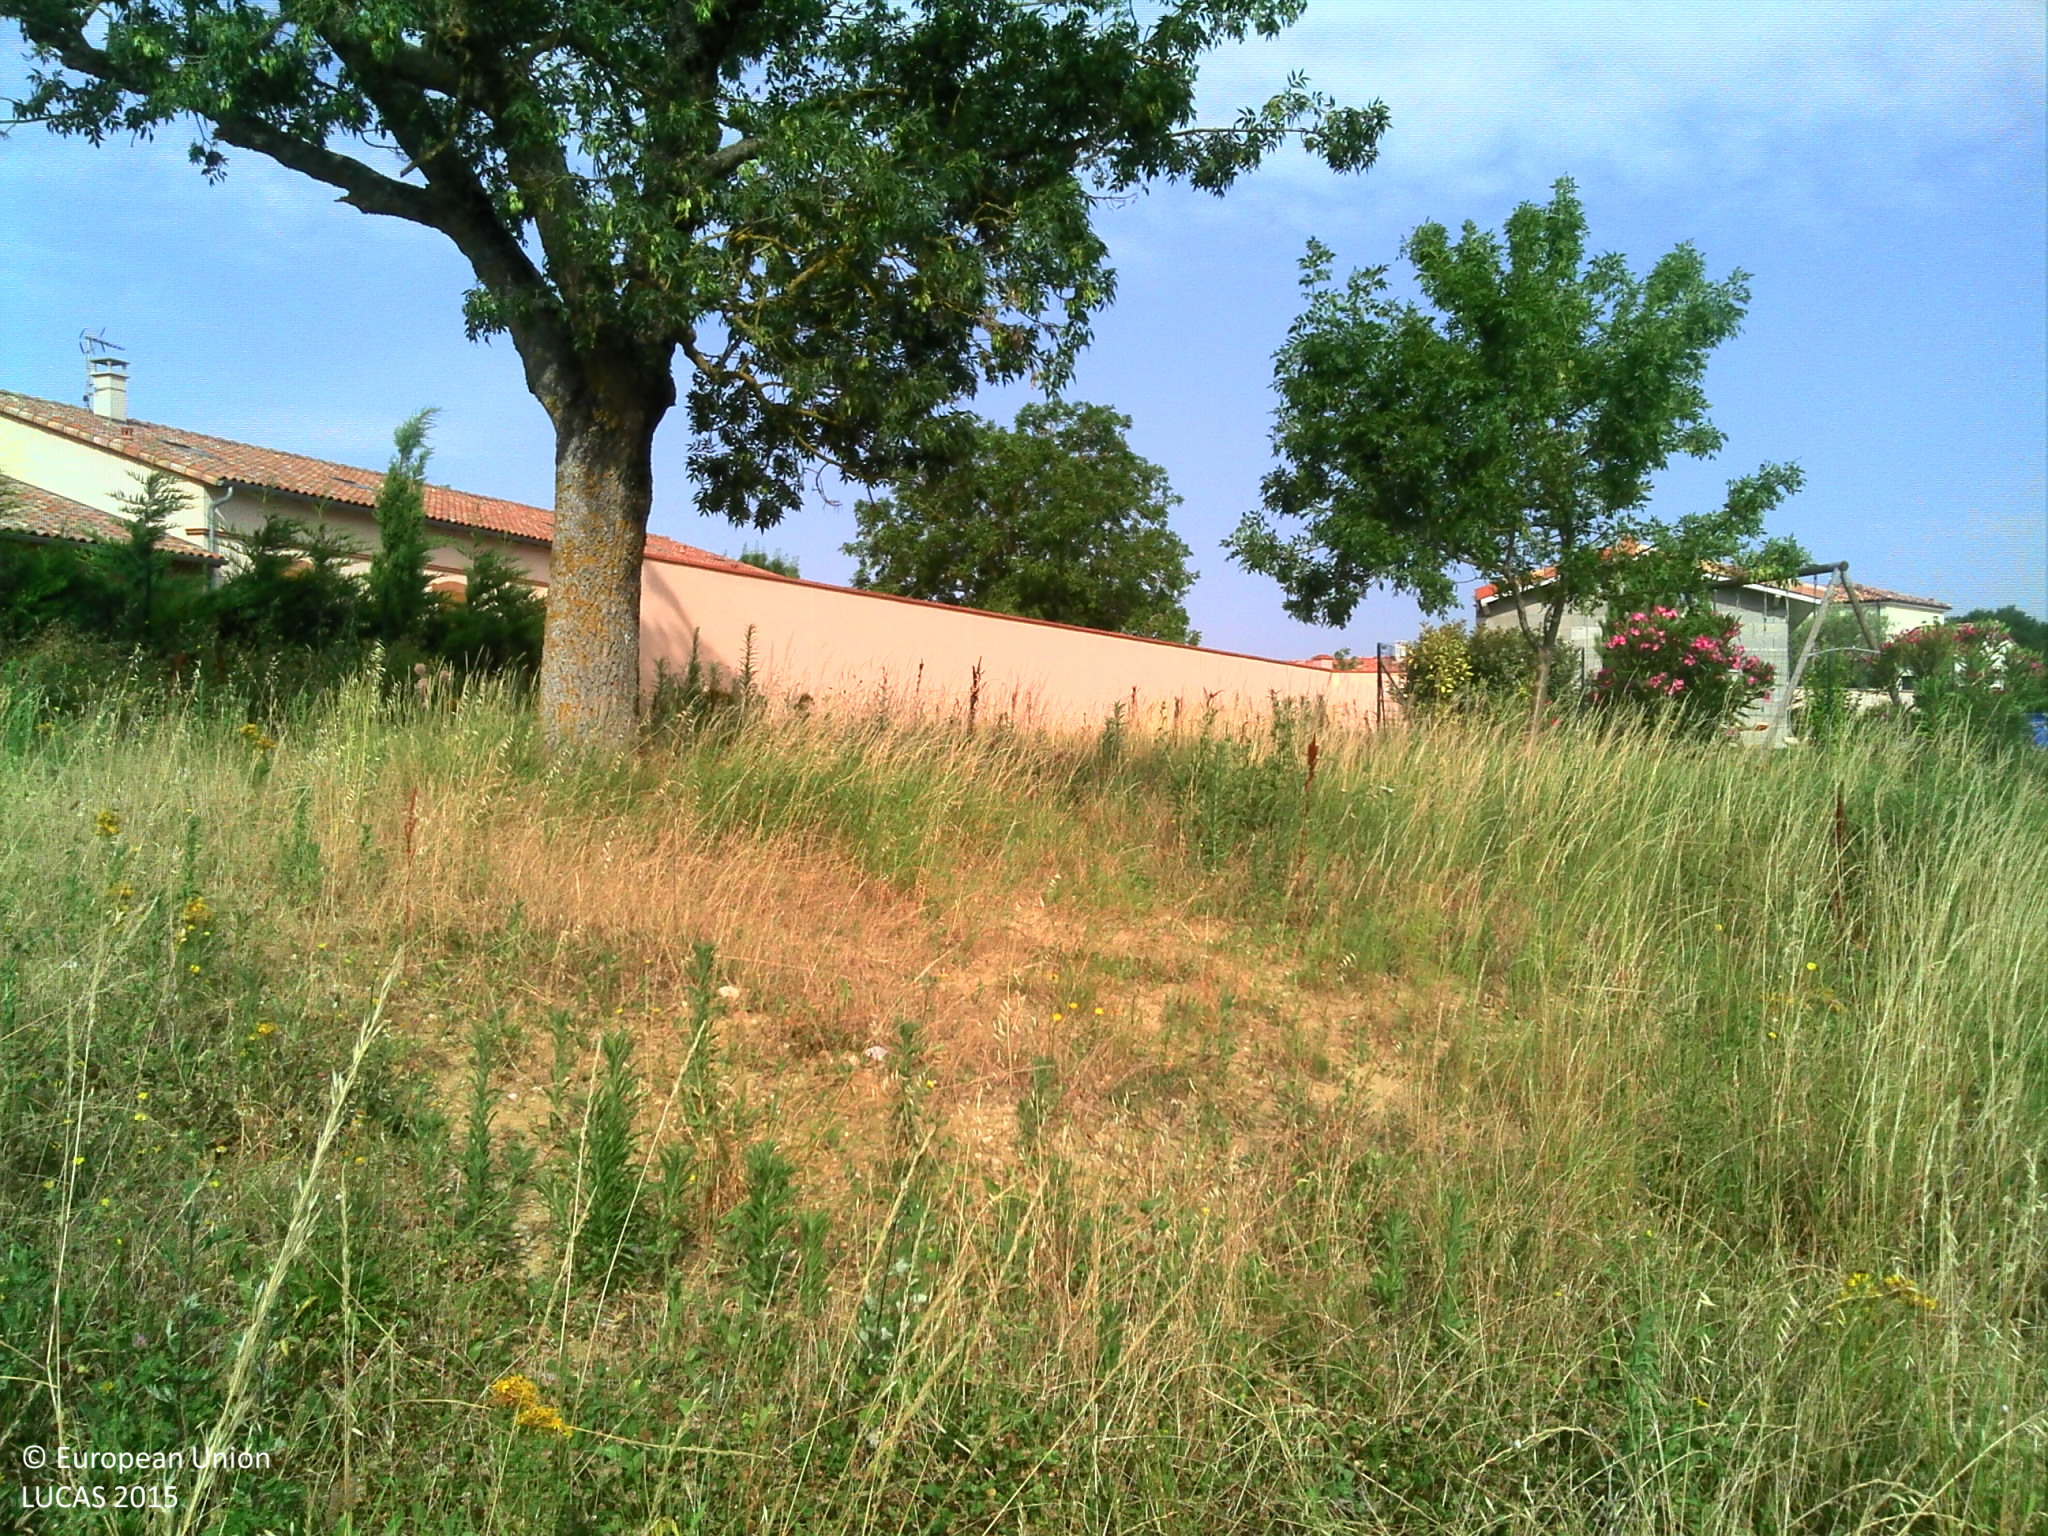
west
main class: Grassland
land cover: Spontaneously vegetated surfaces
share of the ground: > 75 %
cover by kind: herbaceous plants 90 %
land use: Semi-natural and natural areas not in use
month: July
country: FR
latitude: 43.5602
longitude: 1.6474
